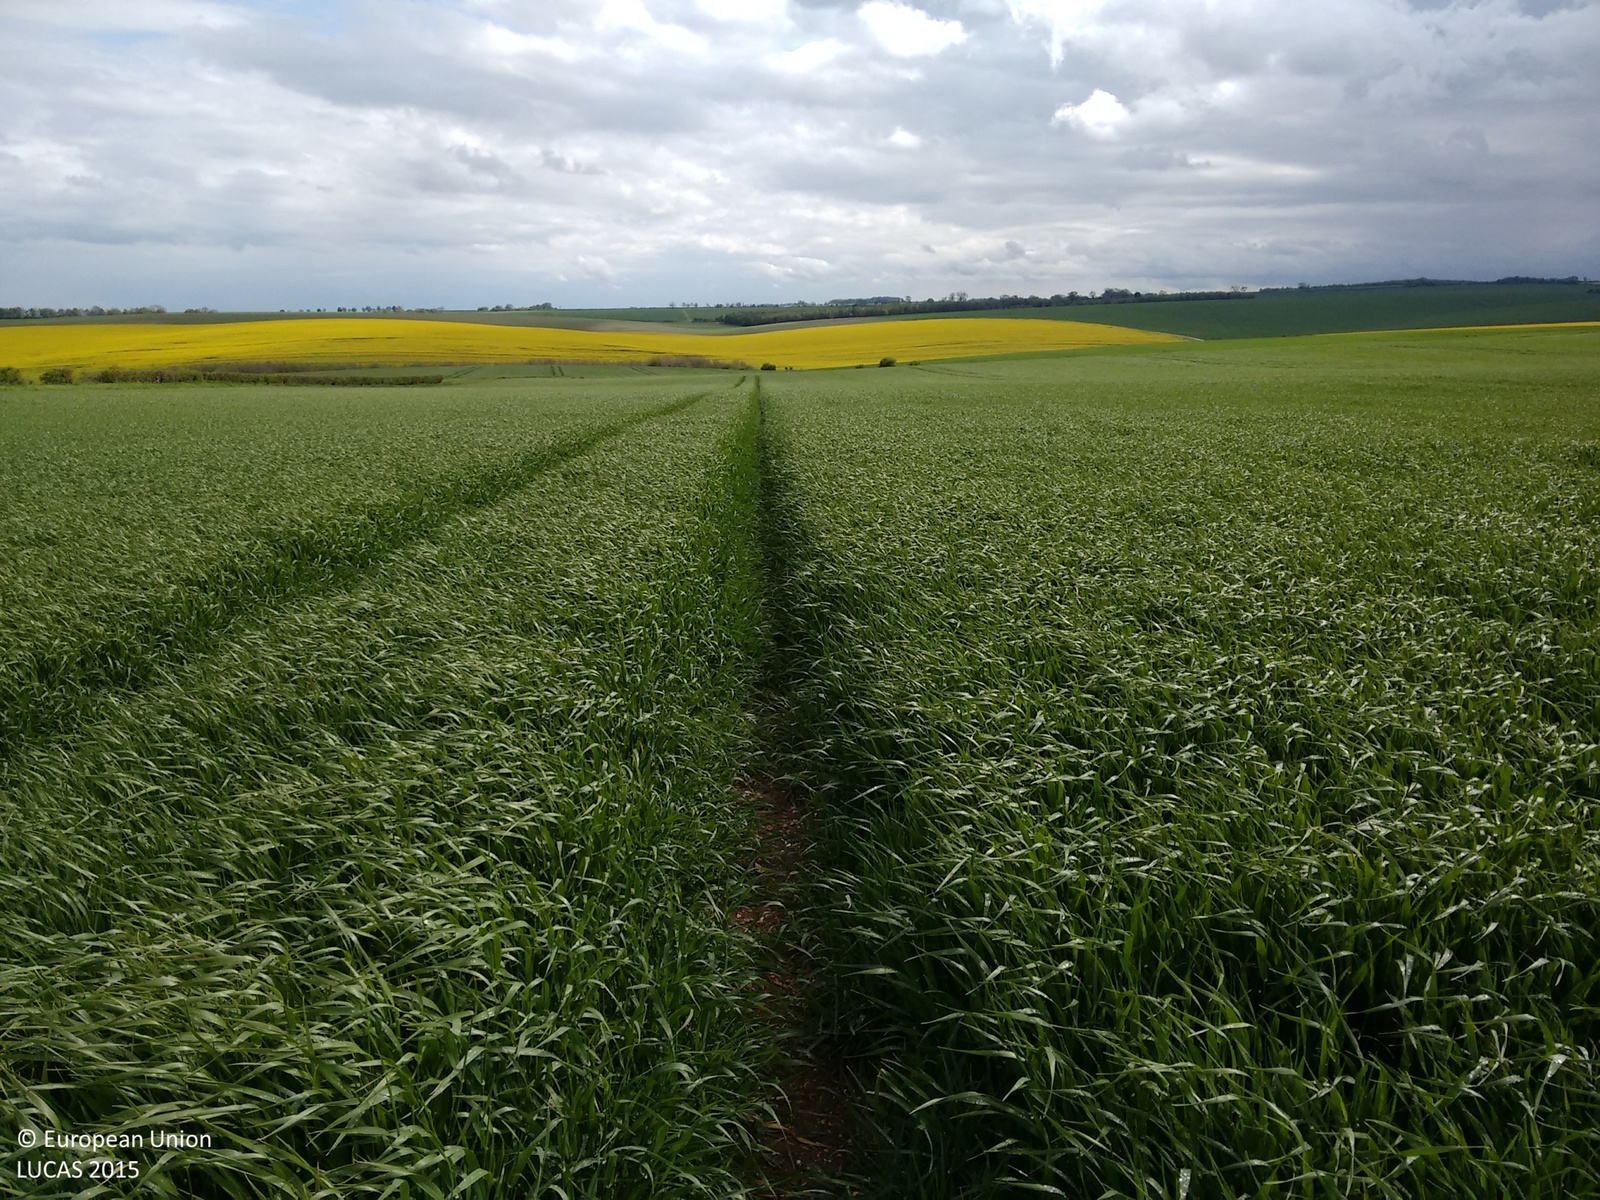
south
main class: Cropland
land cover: Barley
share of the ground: > 75 %
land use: Agriculture (excluding fallow land and kitchen gardens)
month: May
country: GB
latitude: 53.3121
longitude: -0.0131
